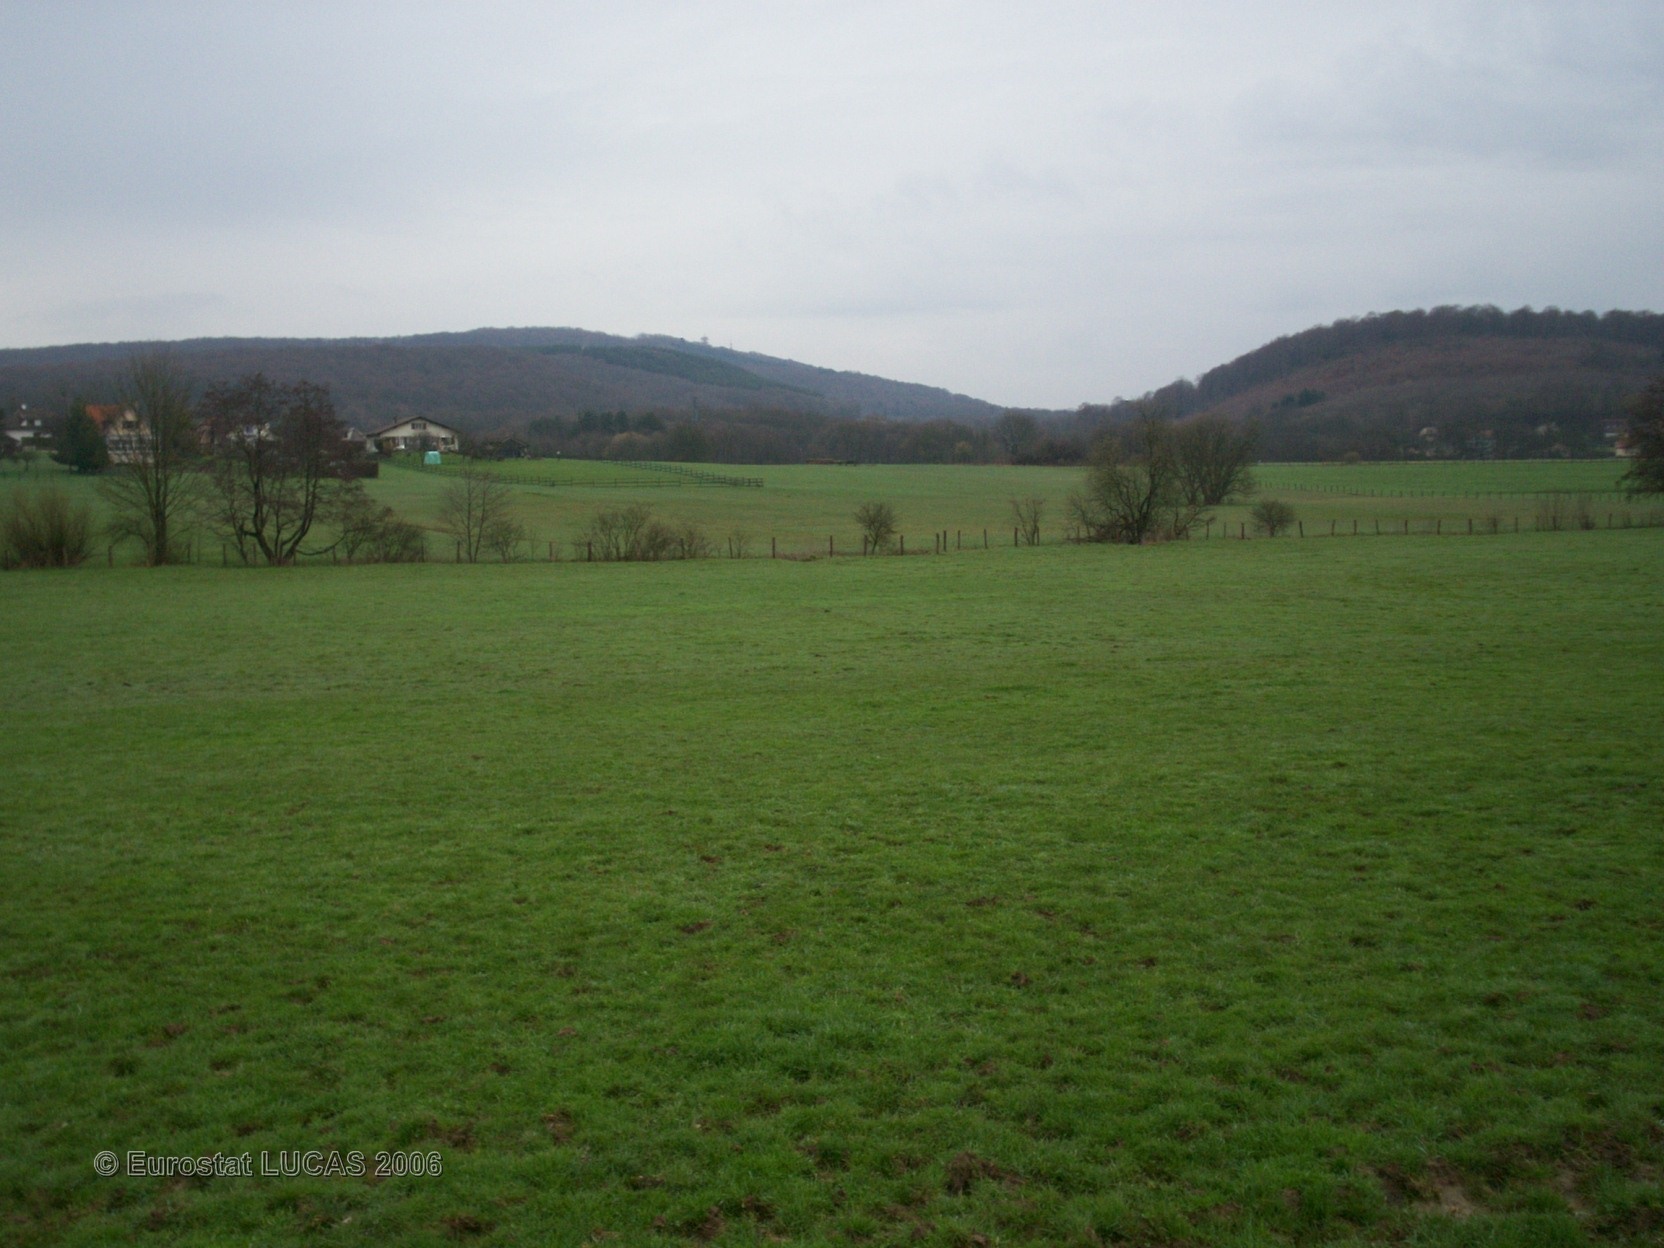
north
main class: Grassland
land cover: Grassland without tree/shrub cover
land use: Agriculture (excluding fallow land and kitchen gardens)
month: April
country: FR
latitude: 47.6366
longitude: 6.7939
